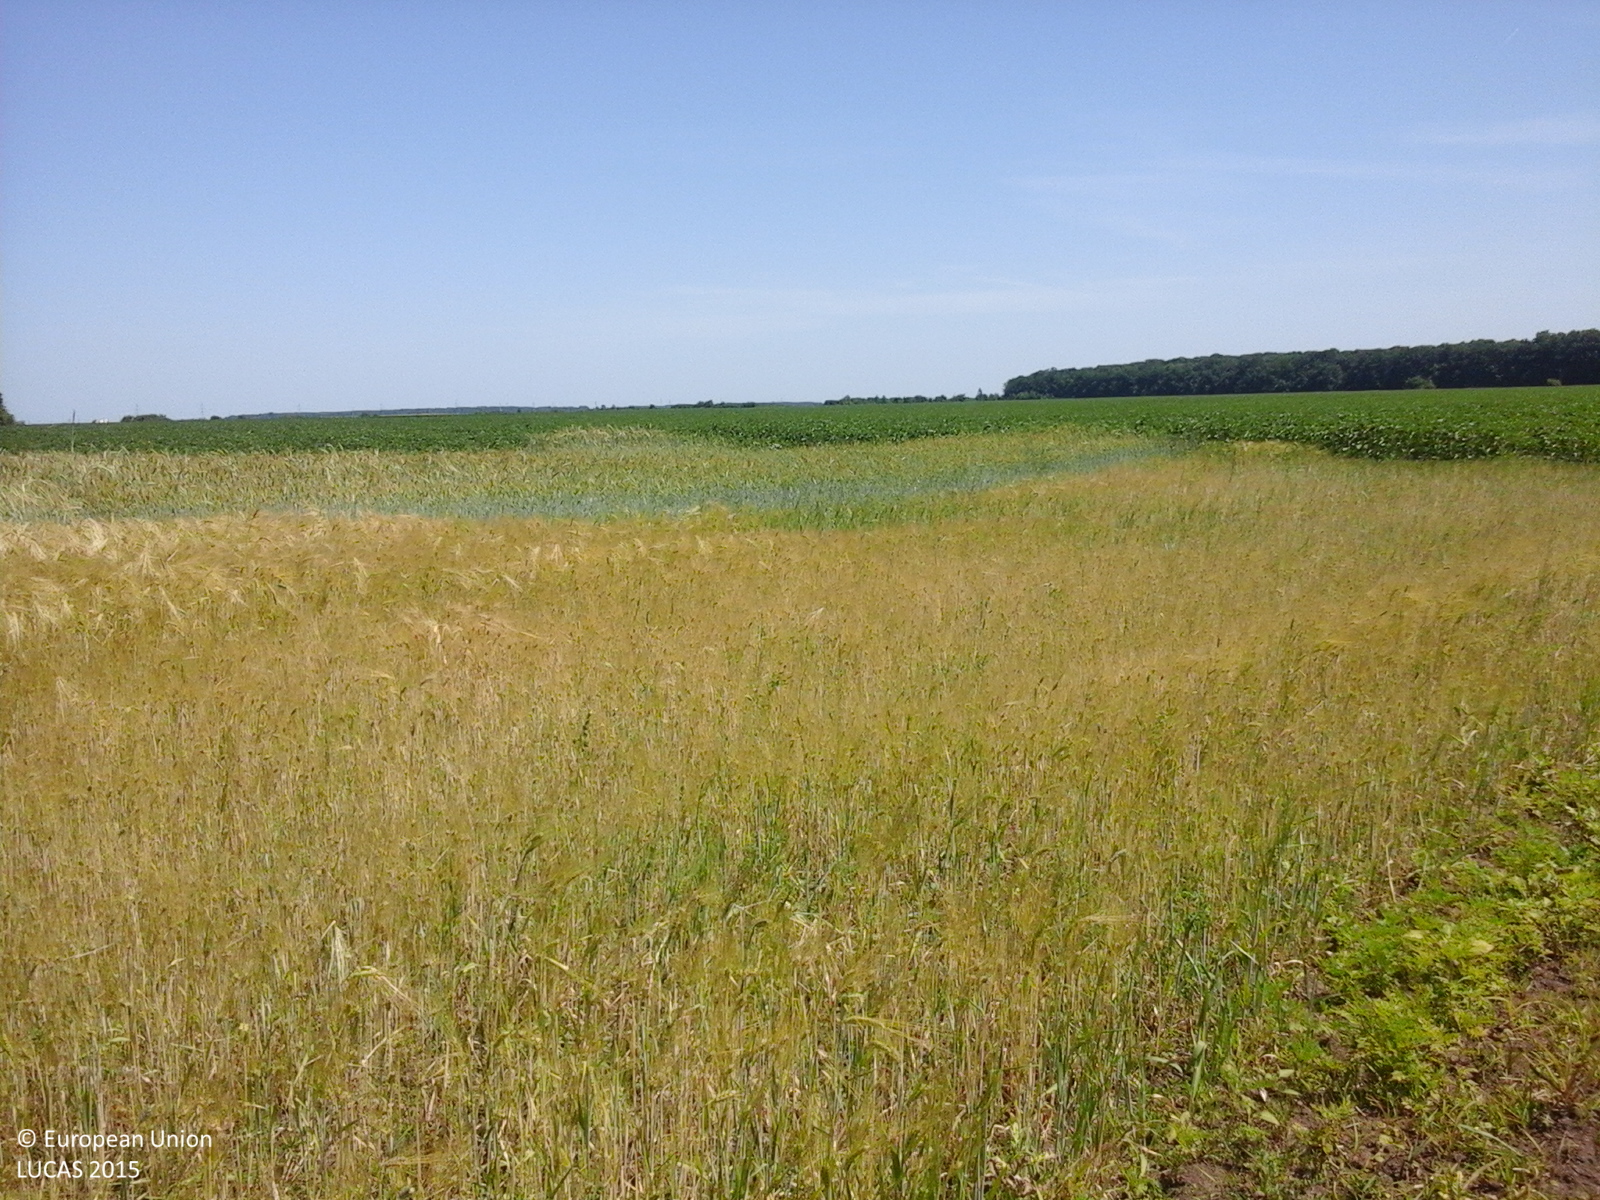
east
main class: Cropland
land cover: Maize
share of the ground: 50 - 75 %
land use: Agriculture (excluding fallow land and kitchen gardens)
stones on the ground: < 10 %
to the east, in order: Maize; Oats; Common wheat; Sunflower; Tracks; Sunflower
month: June
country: RO
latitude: 44.9180
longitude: 26.1095
